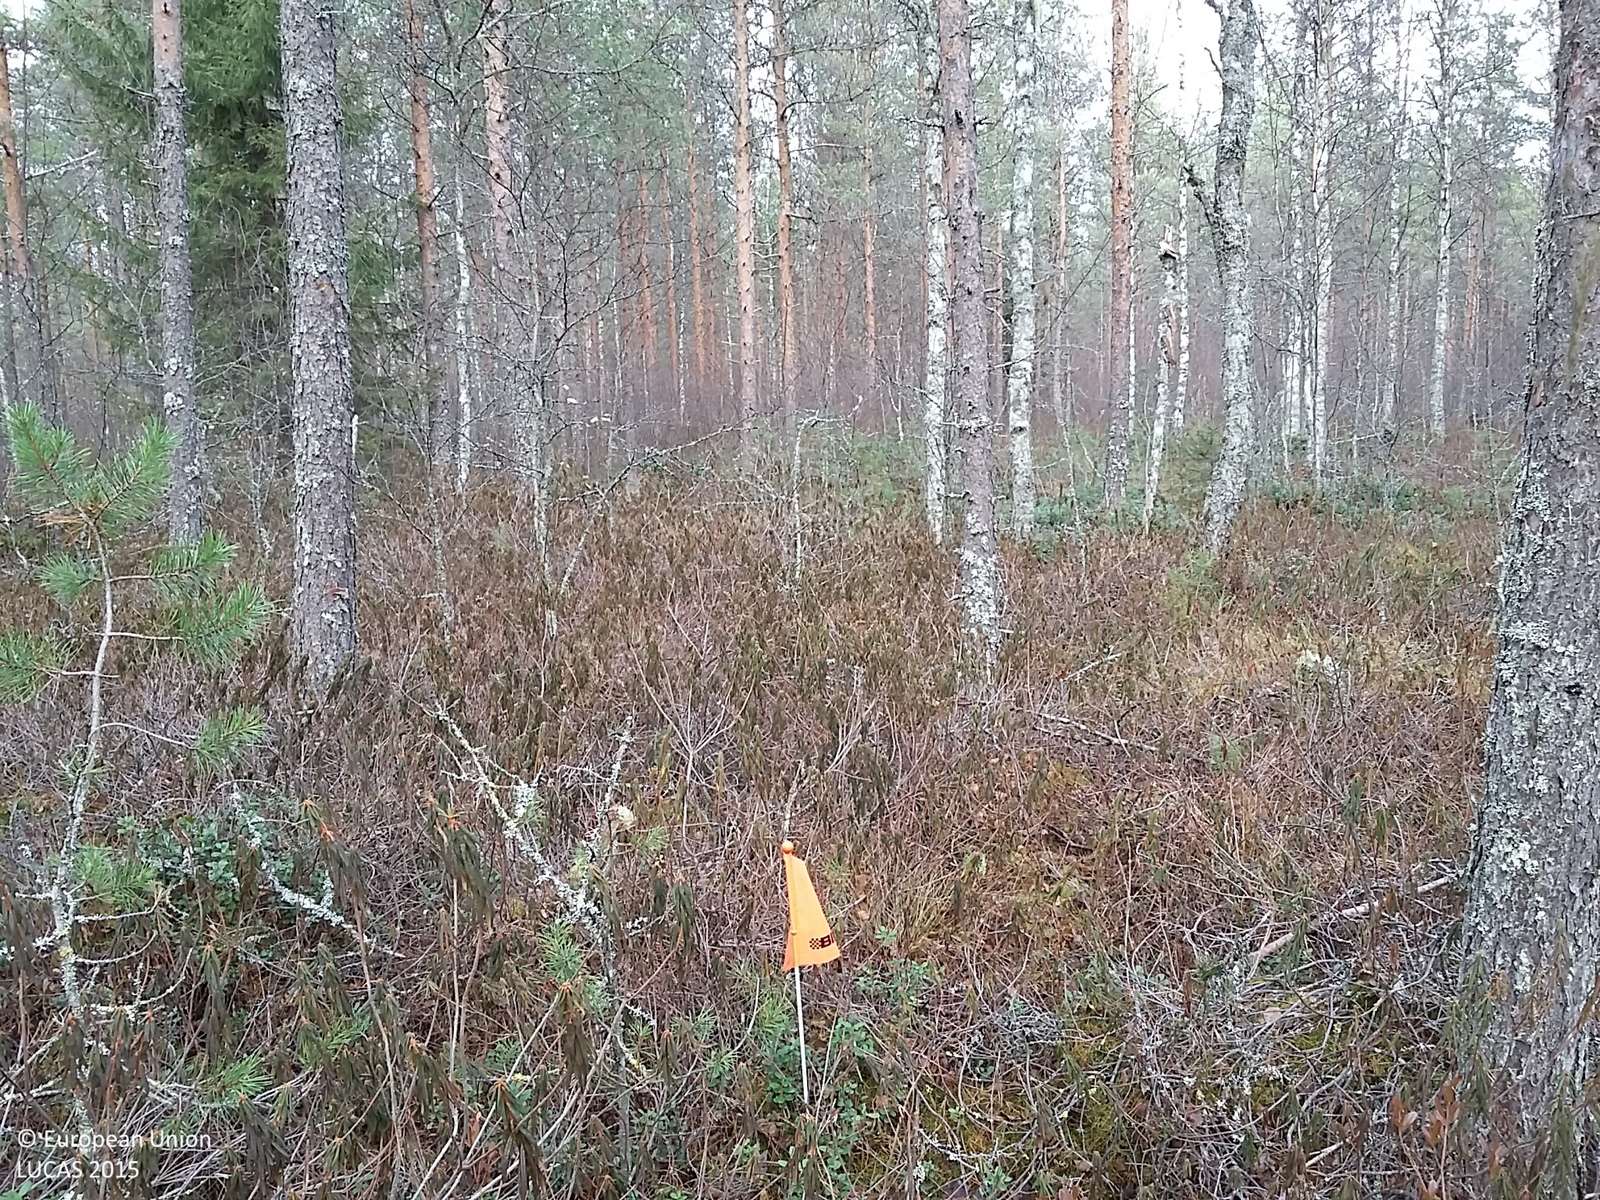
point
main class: Woodland
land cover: Pine dominated mixed woodland
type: boreal forest
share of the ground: > 75 %
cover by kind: coniferous forest trees 55 %, broadleaved forest trees 25 %, shrubs 15 %, lichens and mosses 5 %
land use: Forestry
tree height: > 5 m
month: October
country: FI
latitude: 64.2753
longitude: 25.1378
